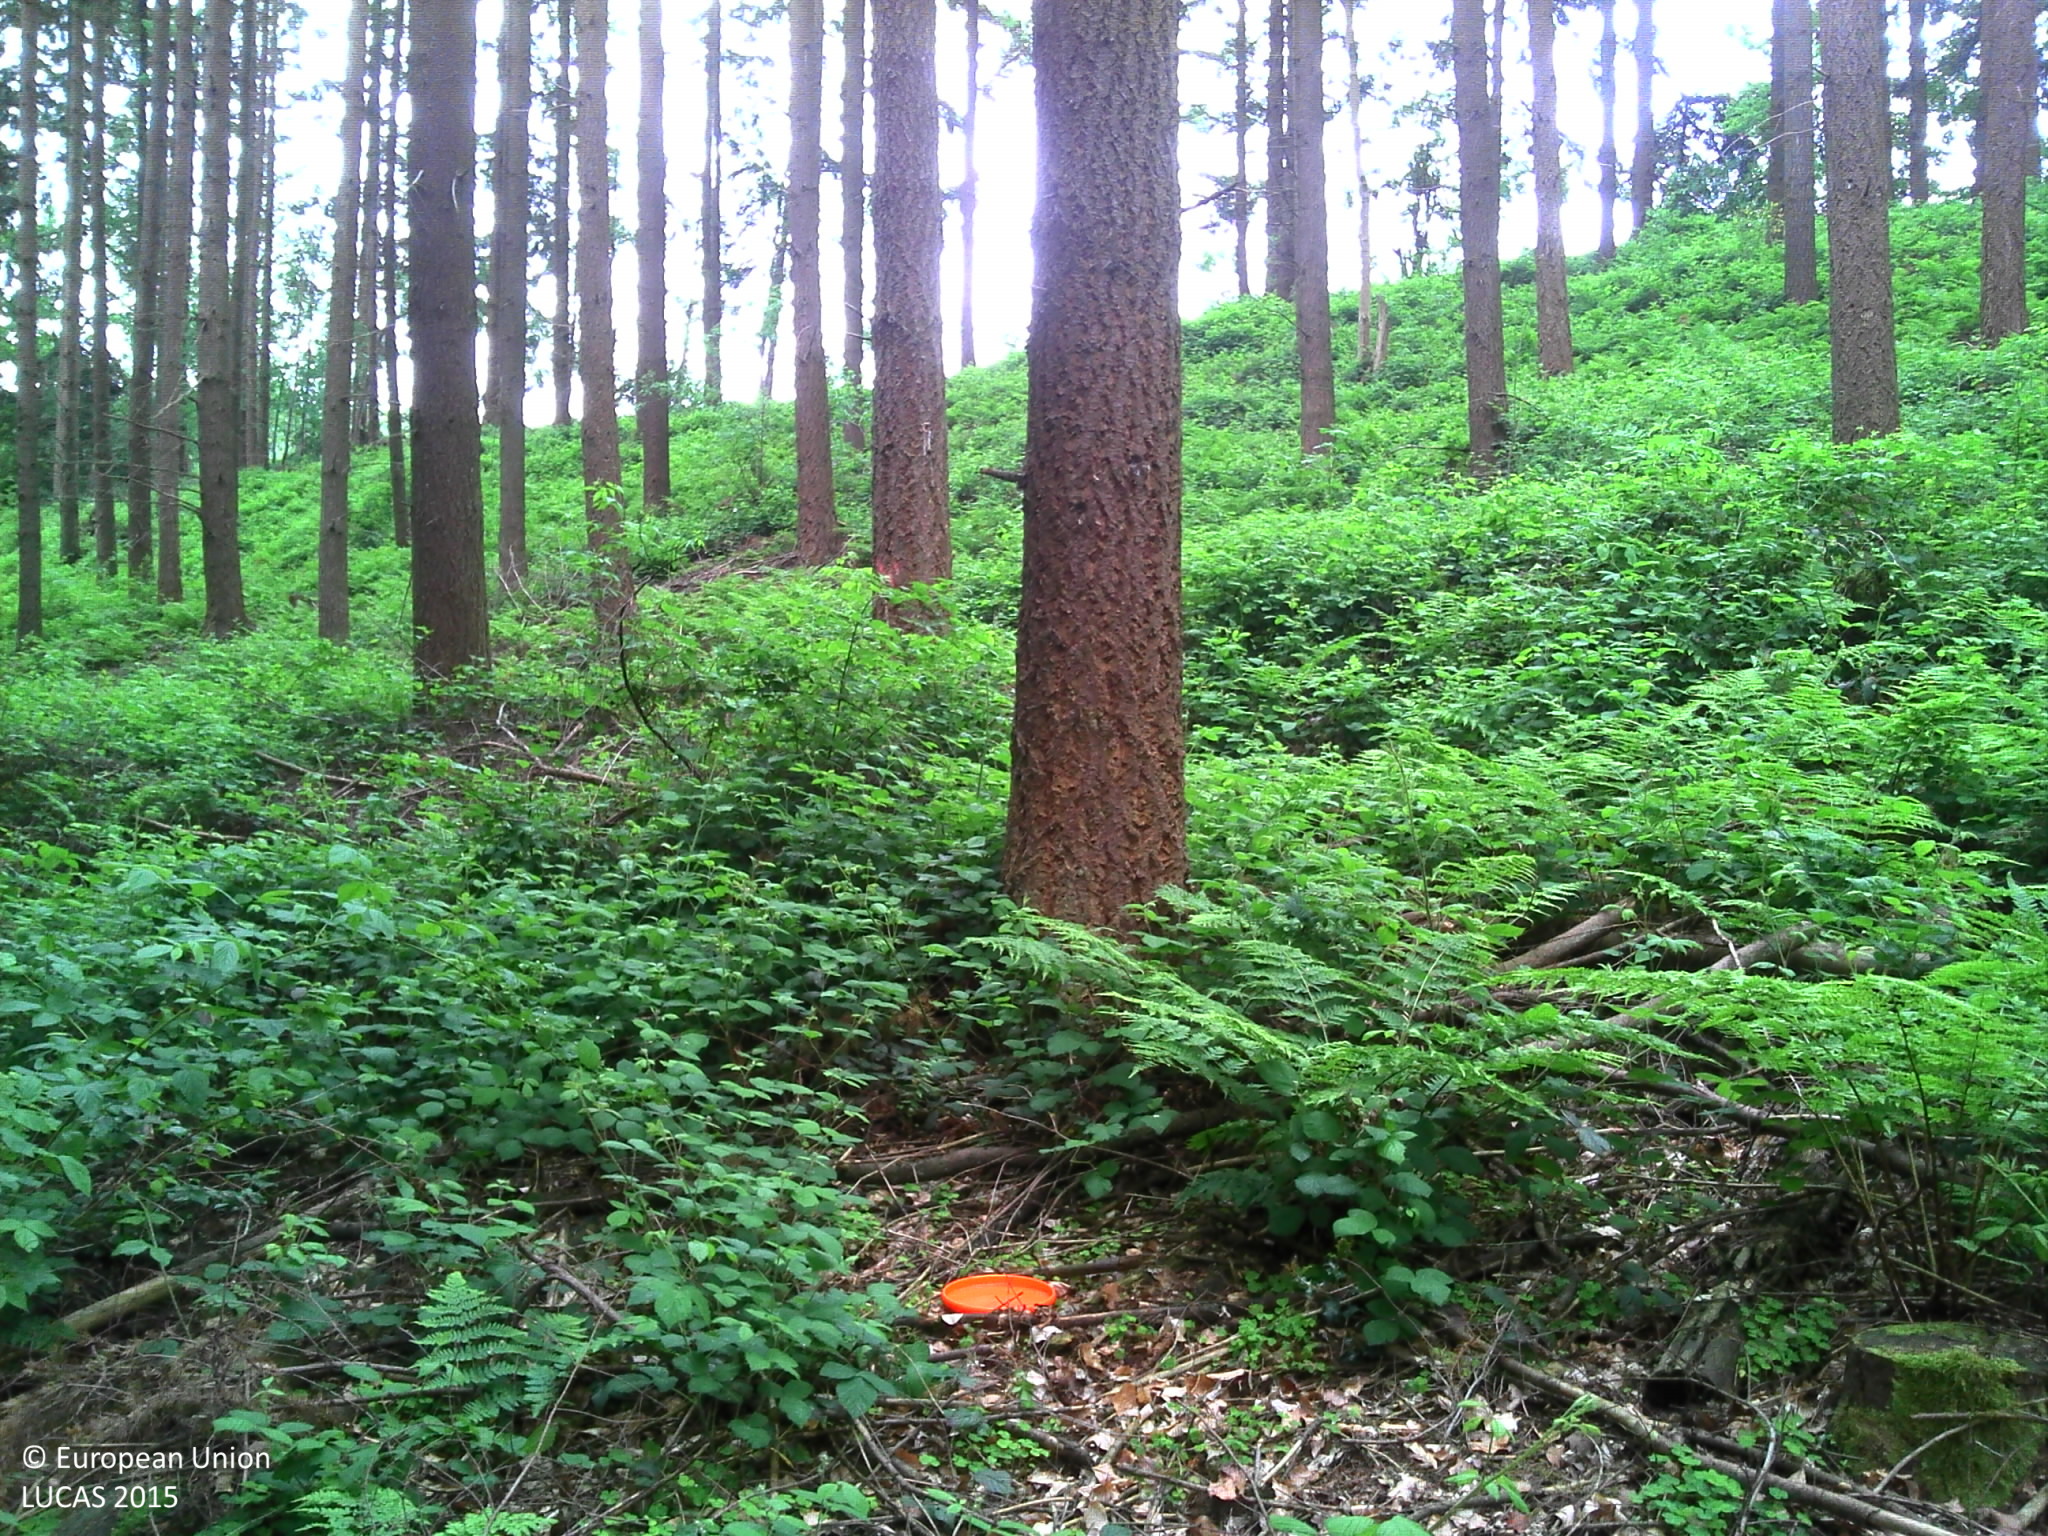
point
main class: Woodland
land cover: Other coniferous woodland
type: exotic forest
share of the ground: > 75 %
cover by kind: coniferous forest trees 90 %, herbaceous plants 10 %
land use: Forestry
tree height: > 5 m
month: June
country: BE
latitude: 50.3884
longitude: 5.6242
